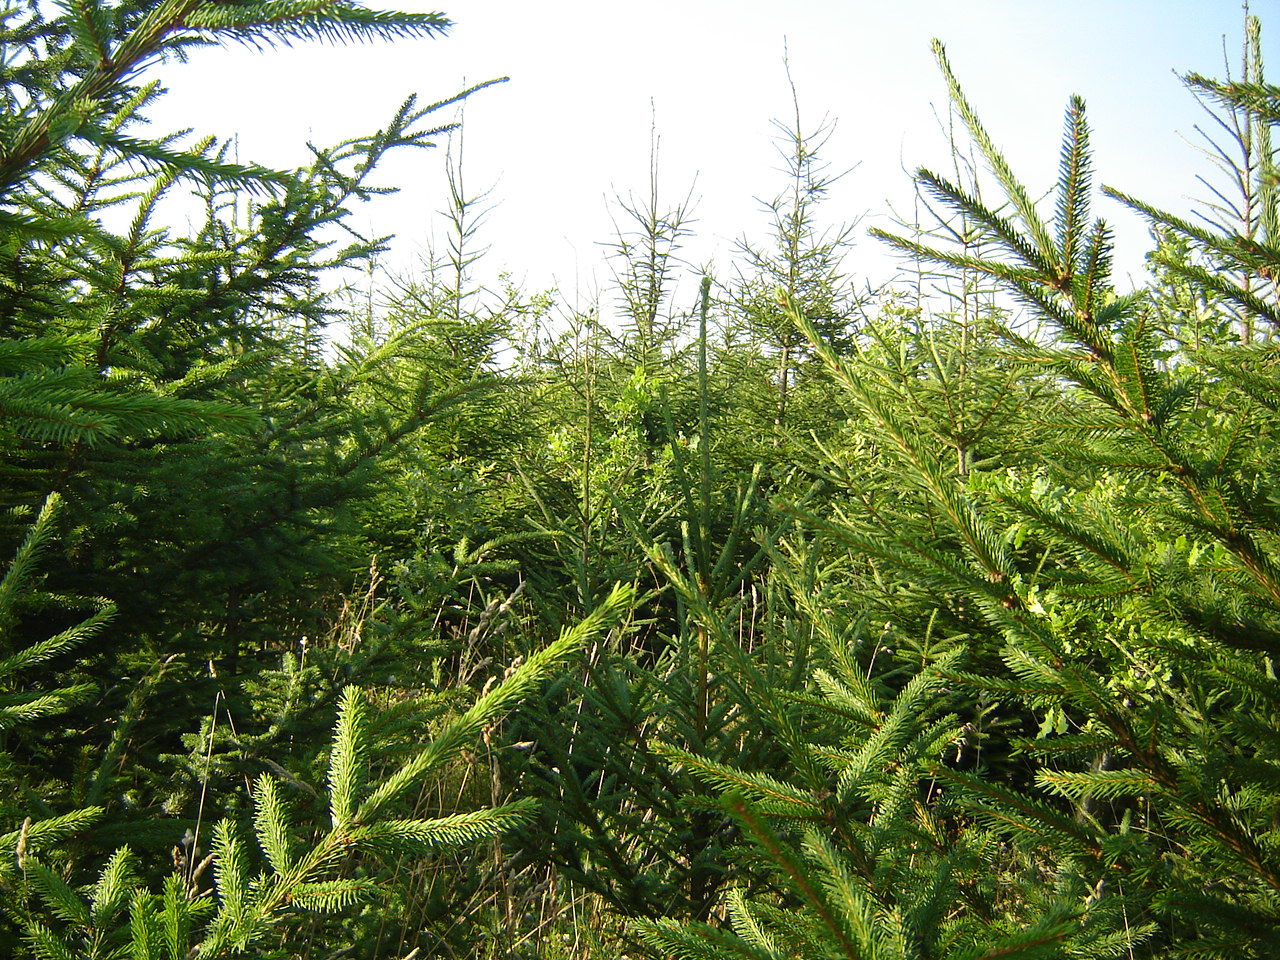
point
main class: Woodland
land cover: Spruce dominated coniferous woodland
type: hemiboreal forest and nemoral coniferous forest and mixed broadleaved-coniferous forest
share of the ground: > 75 %
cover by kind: coniferous forest trees 75 %, broadleaved forest trees 15 %, herbaceous plants 10 %
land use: Forestry
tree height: < 5 m
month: August
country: LT
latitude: 55.2014
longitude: 24.8952
